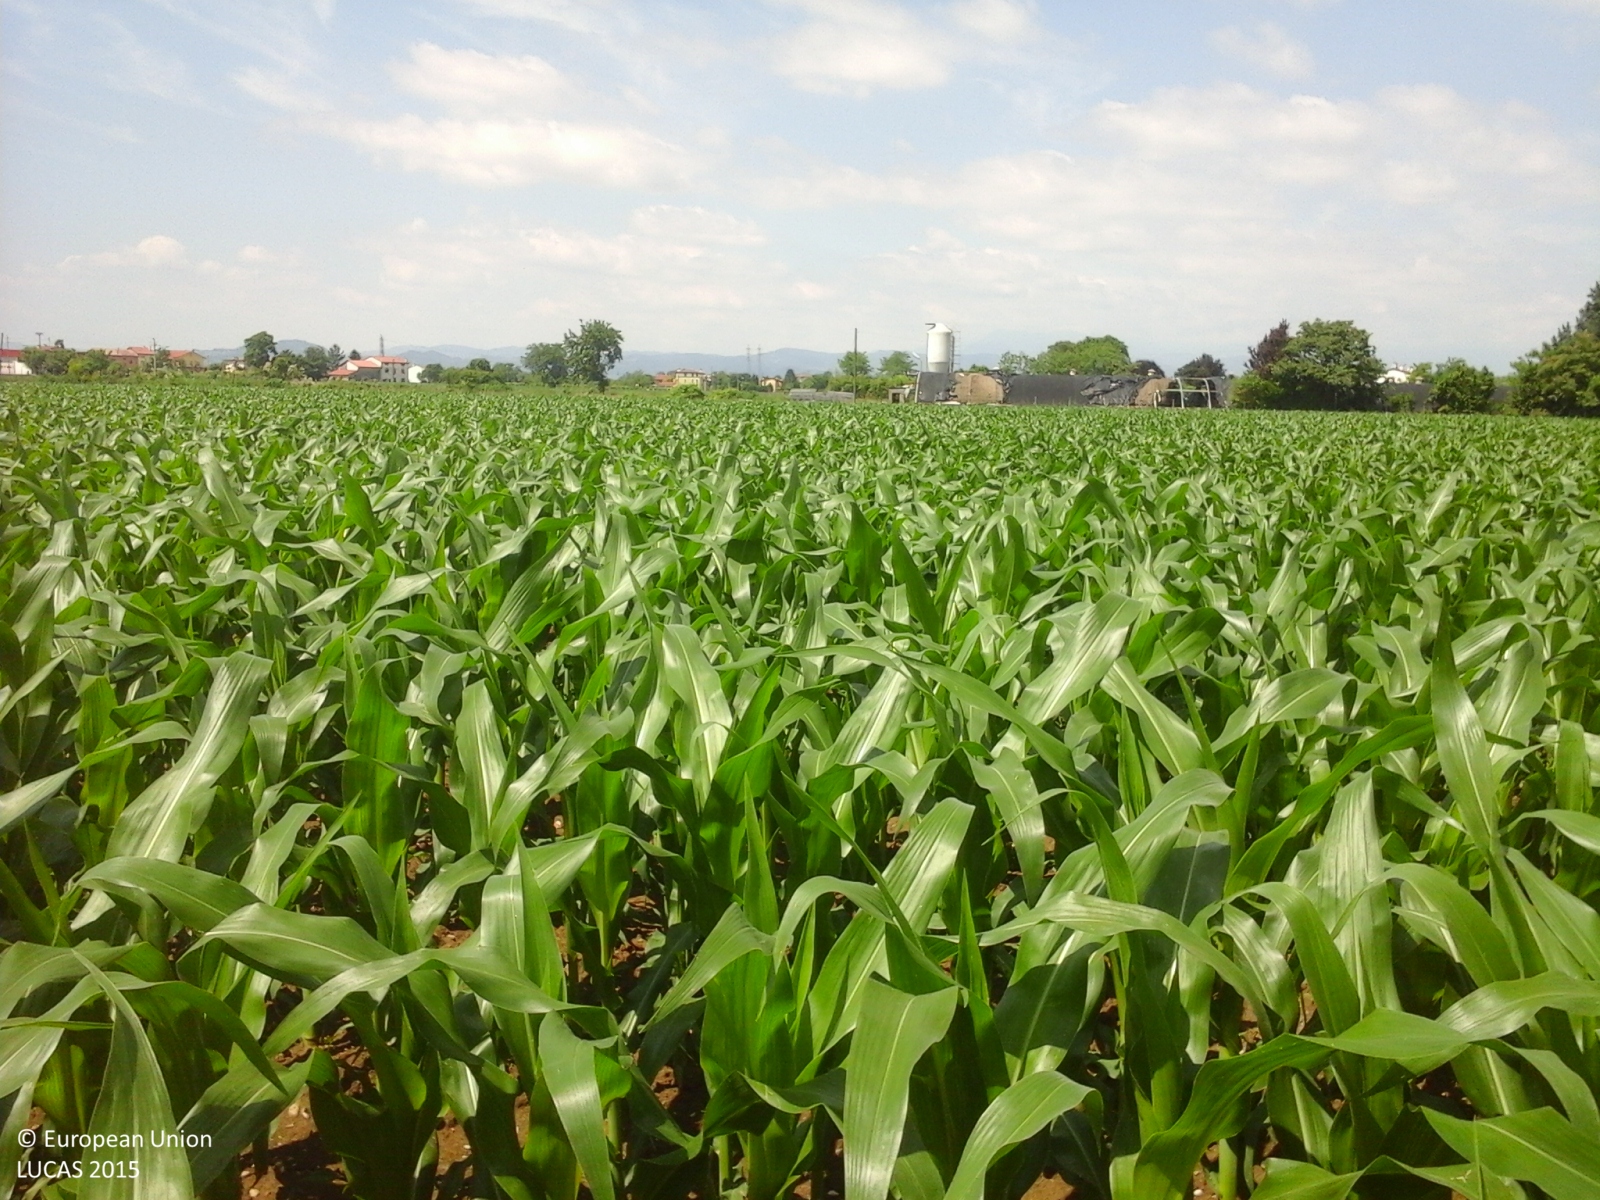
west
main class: Cropland
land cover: Maize
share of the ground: > 75 %
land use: Agriculture (excluding fallow land and kitchen gardens)
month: May
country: IT
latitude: 45.6545
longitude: 11.6016
